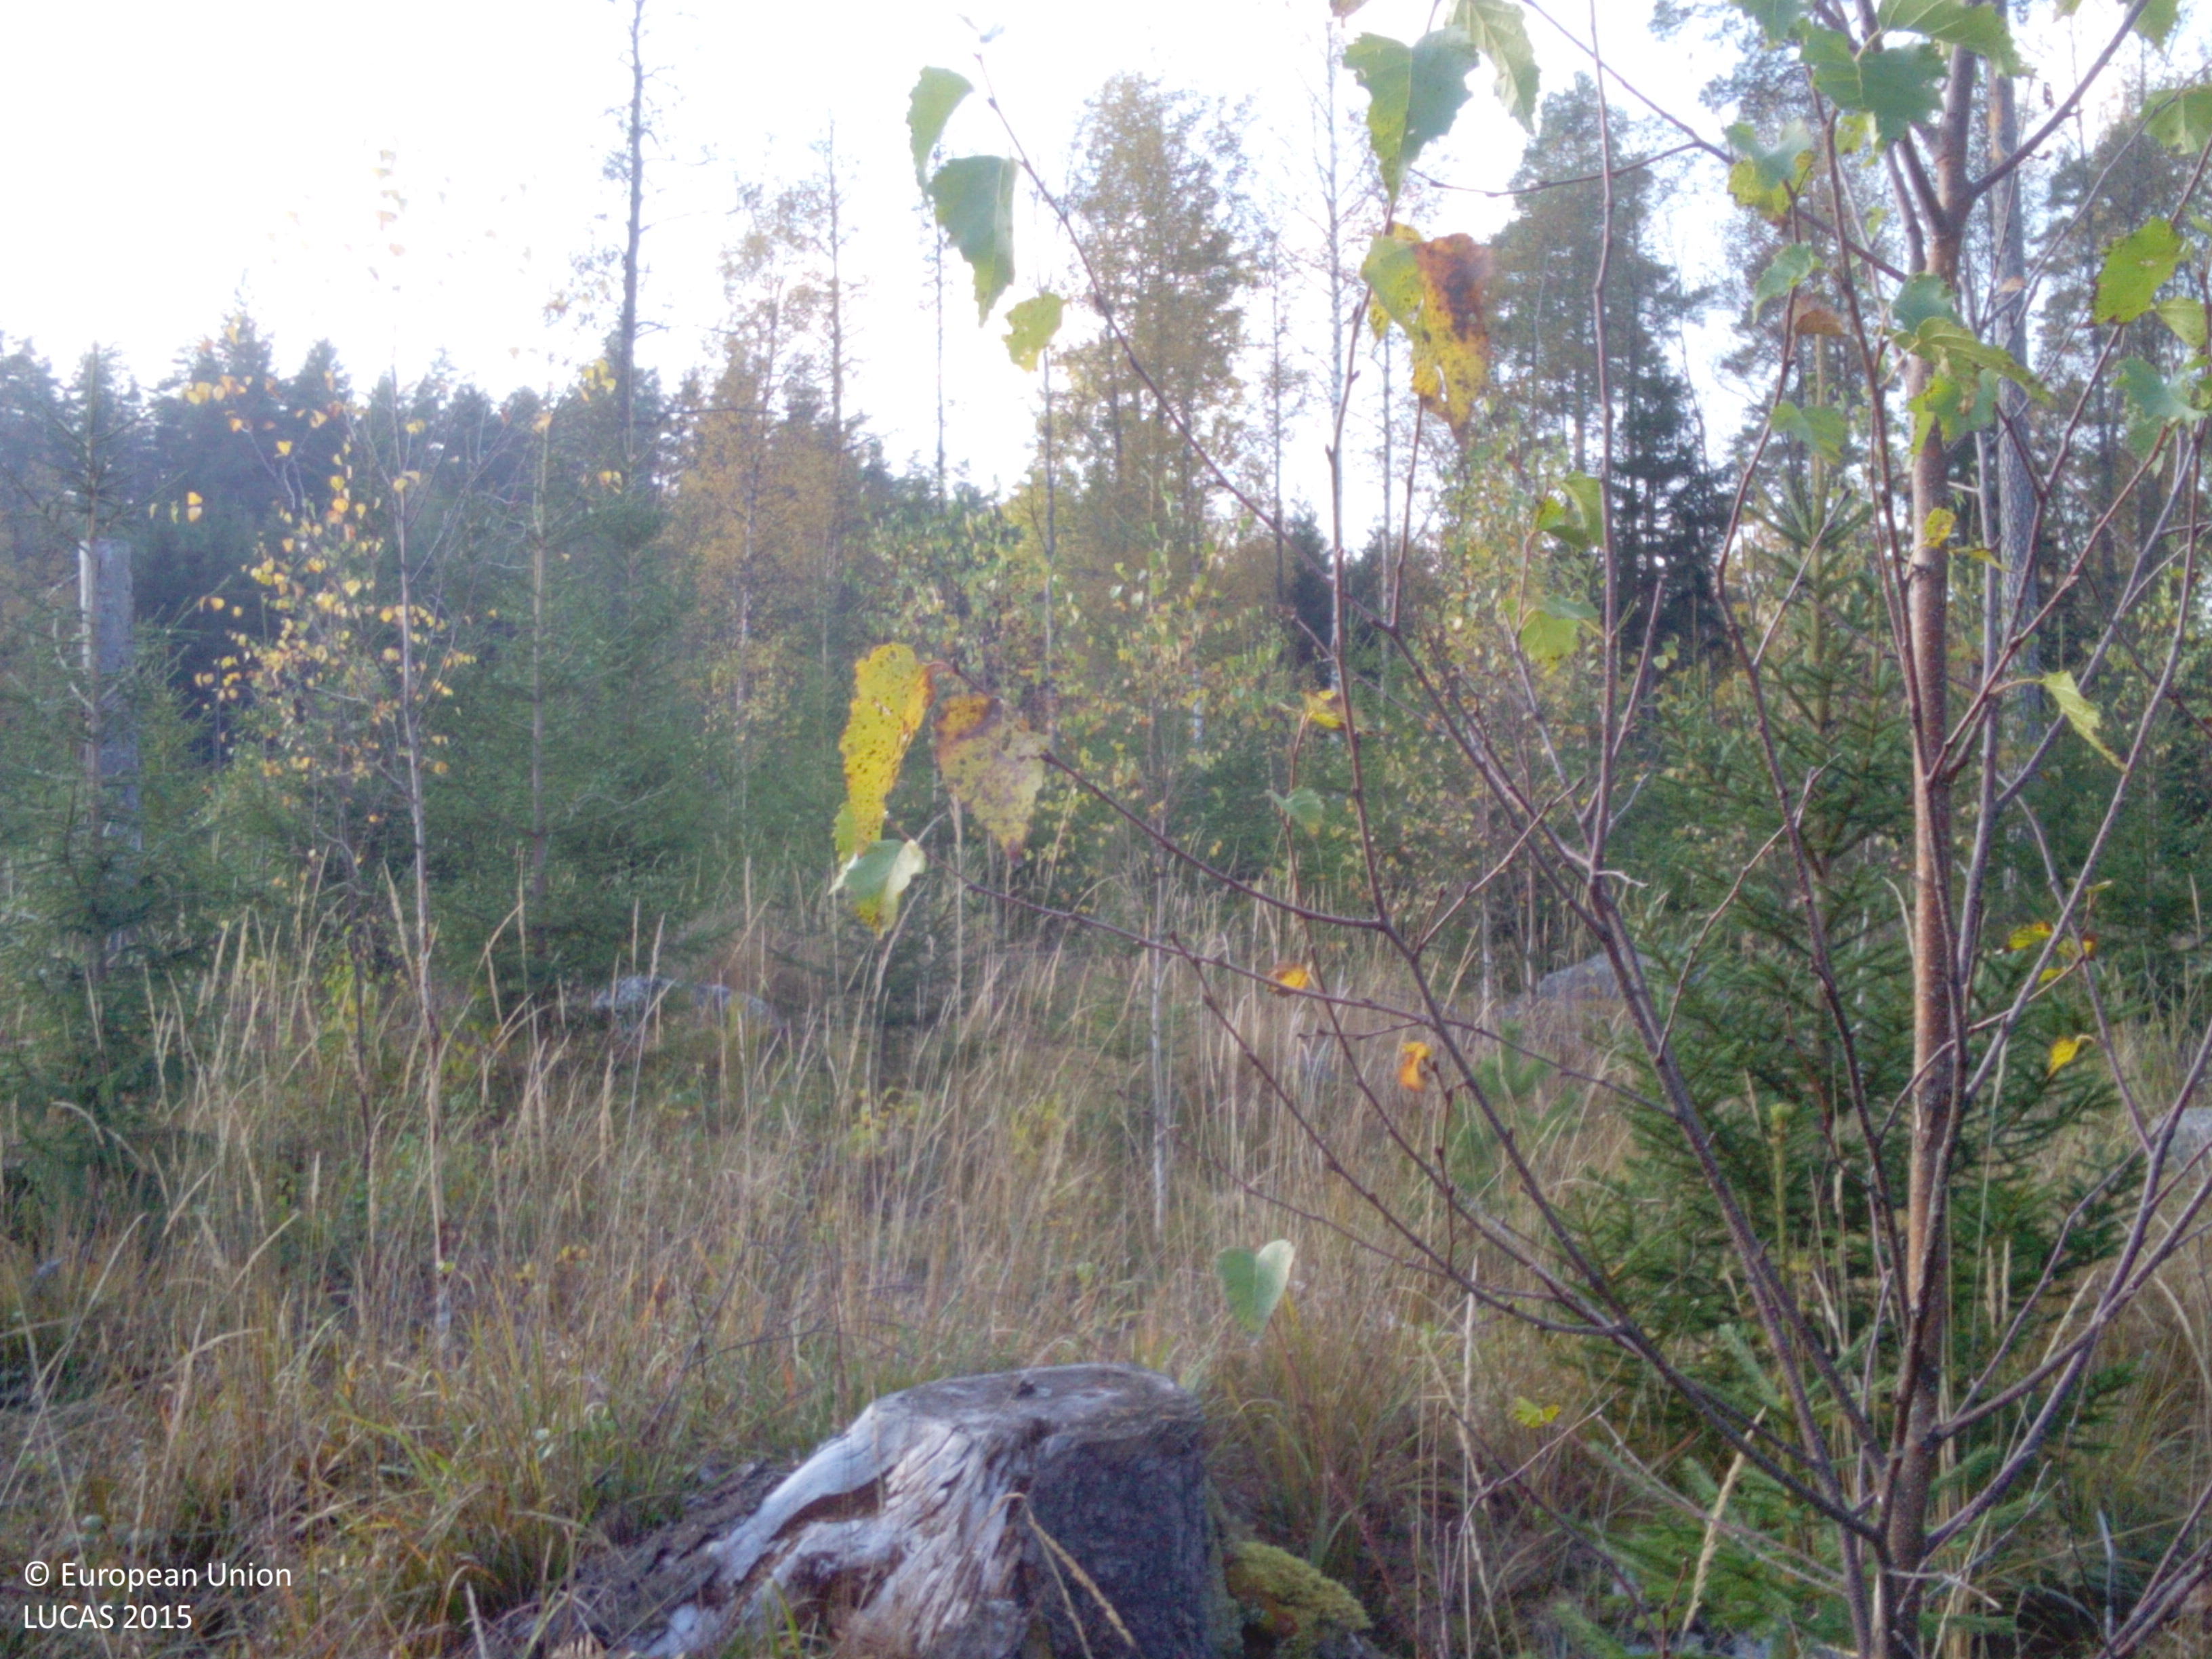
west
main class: Woodland
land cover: Spruce dominated mixed woodland
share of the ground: 50 - 75 %
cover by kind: herbaceous plants 45 %, coniferous forest trees 25 %, broadleaved forest trees 25 %, lichens and mosses 5 %
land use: Forestry
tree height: < 5 m
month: October
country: SE
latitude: 58.8845
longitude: 16.2921
